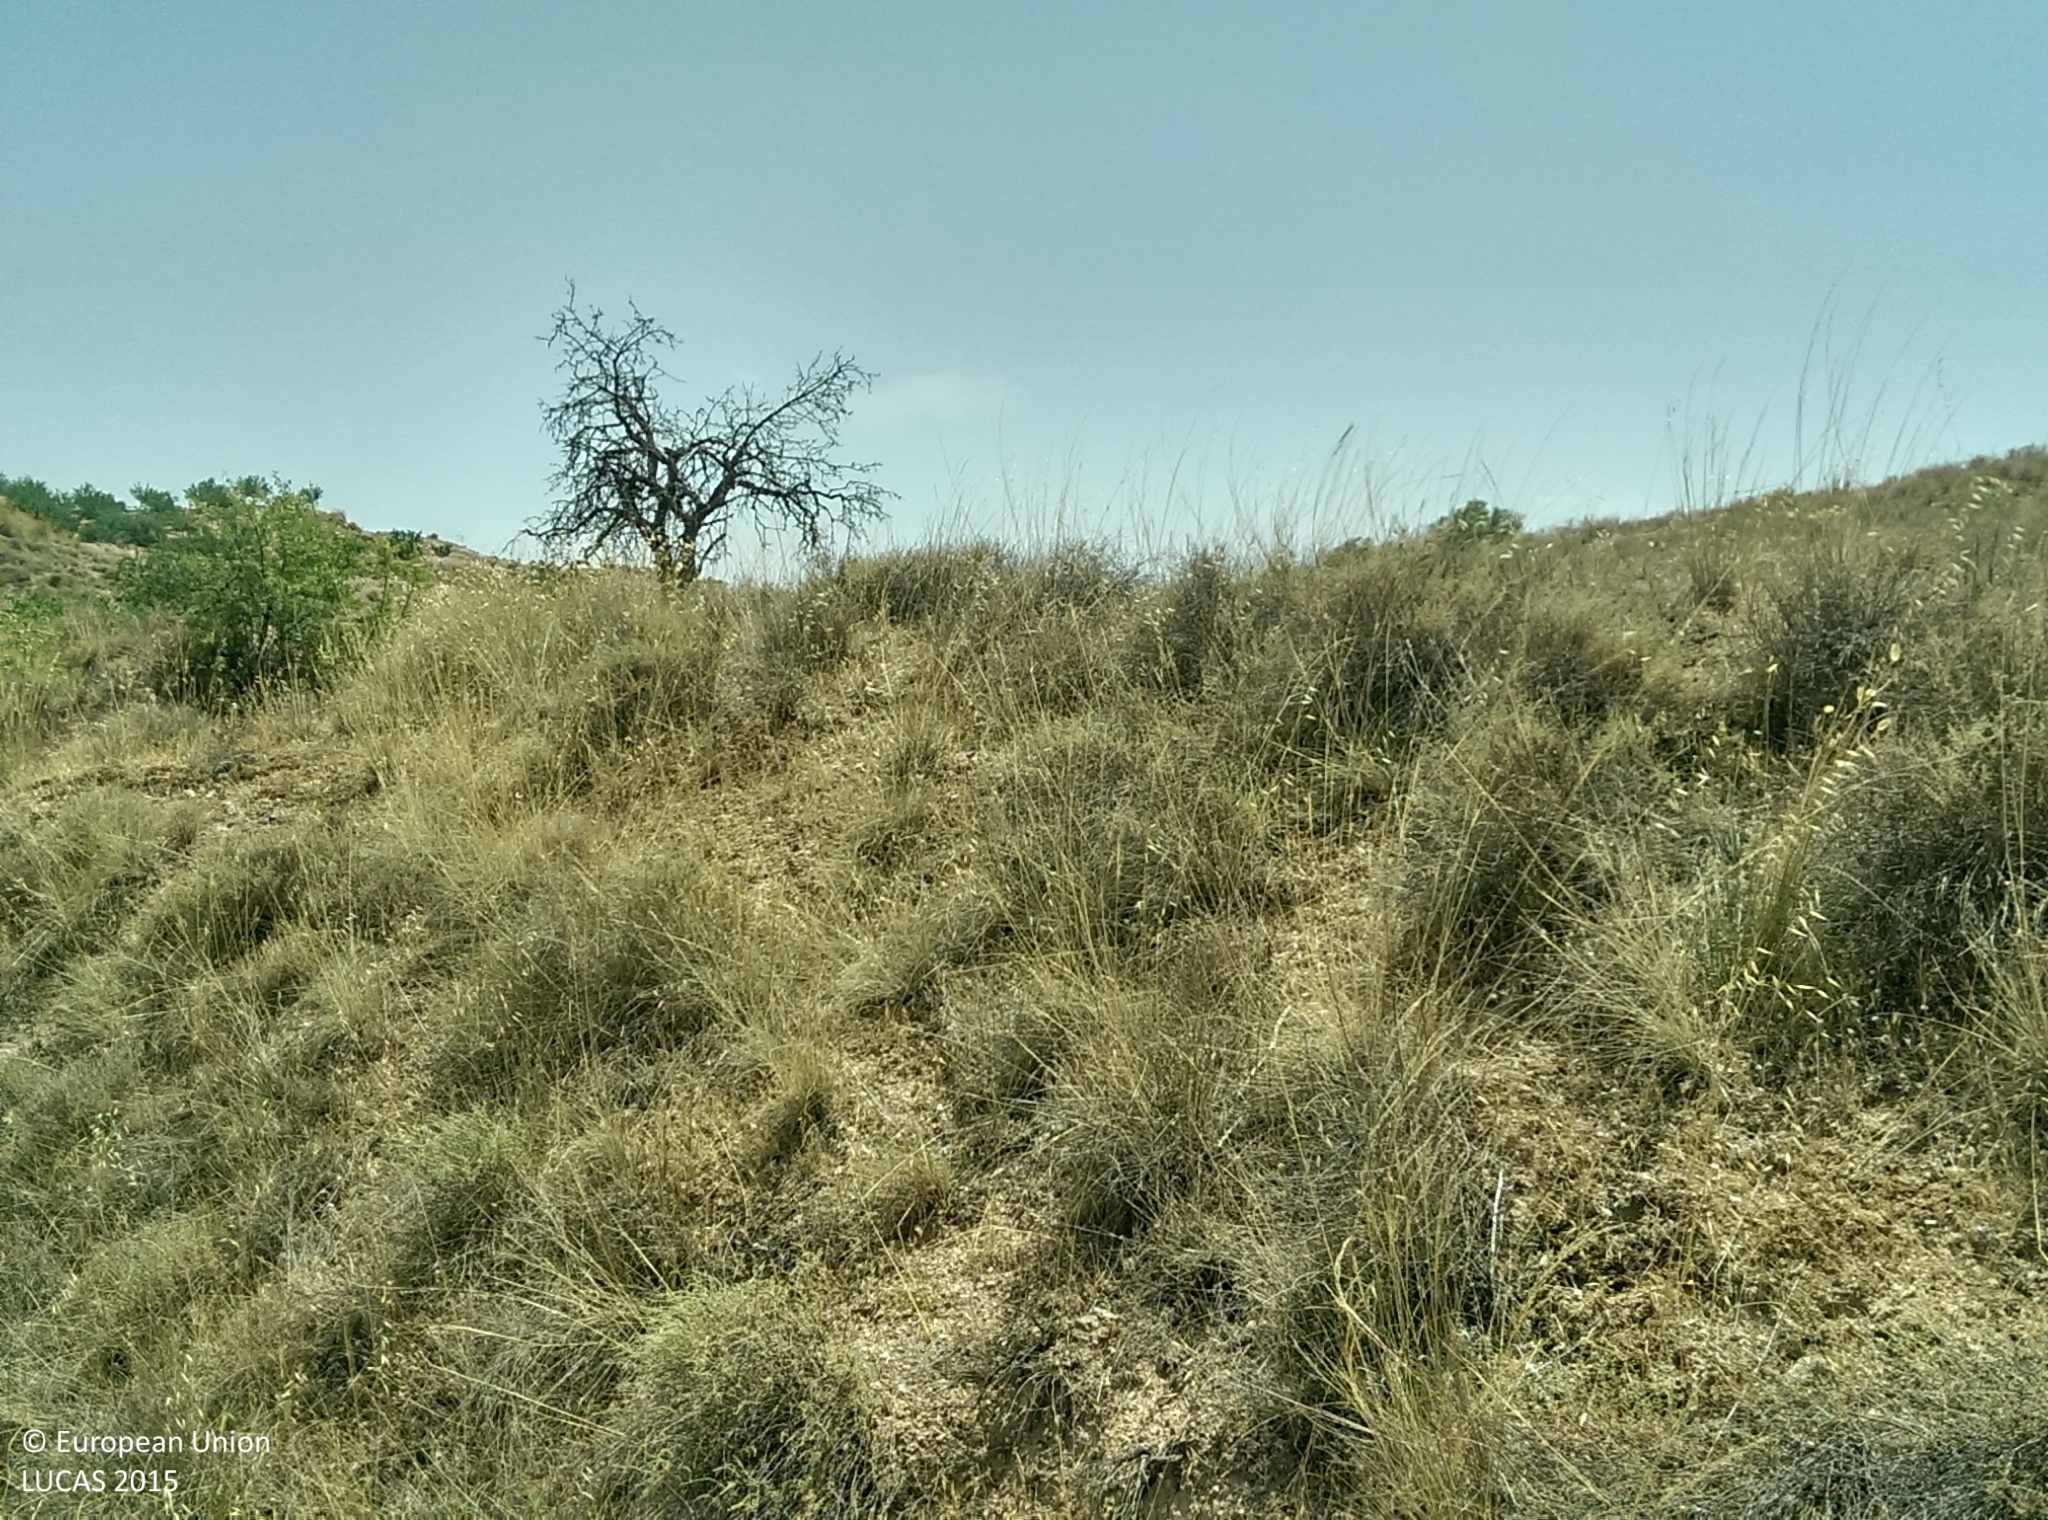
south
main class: Shrubland
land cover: Shrubland with sparse tree cover
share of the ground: 50 - 75 %
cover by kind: shrubs 55 %, herbaceous plants 30 %, unconsolidated bare surface 10 %, coniferous forest trees 5 %
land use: Abandoned areas
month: July
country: ES
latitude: 37.5283
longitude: -2.8771
